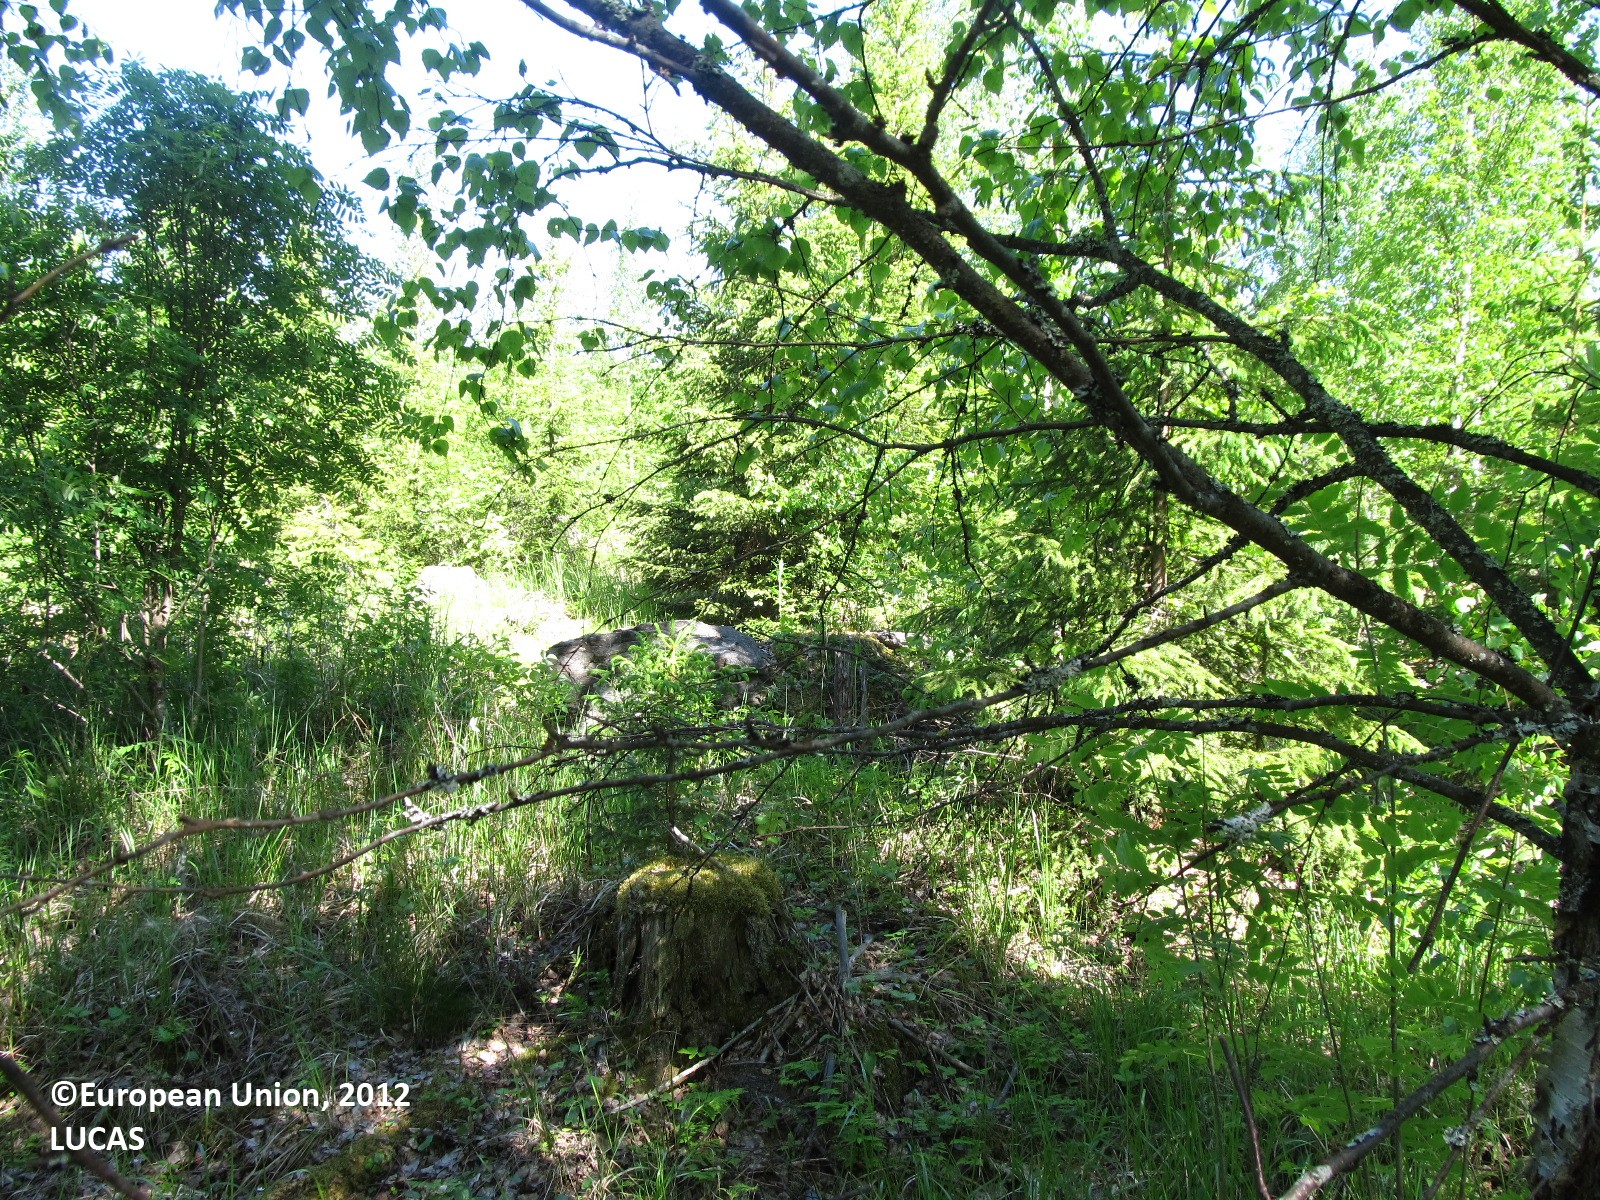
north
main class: Woodland
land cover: Broadleaved woodland
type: boreal forest
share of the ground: 50 - 75 %
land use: Forestry
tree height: > 5 m
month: June
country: FI
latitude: 62.6761
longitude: 27.4457
